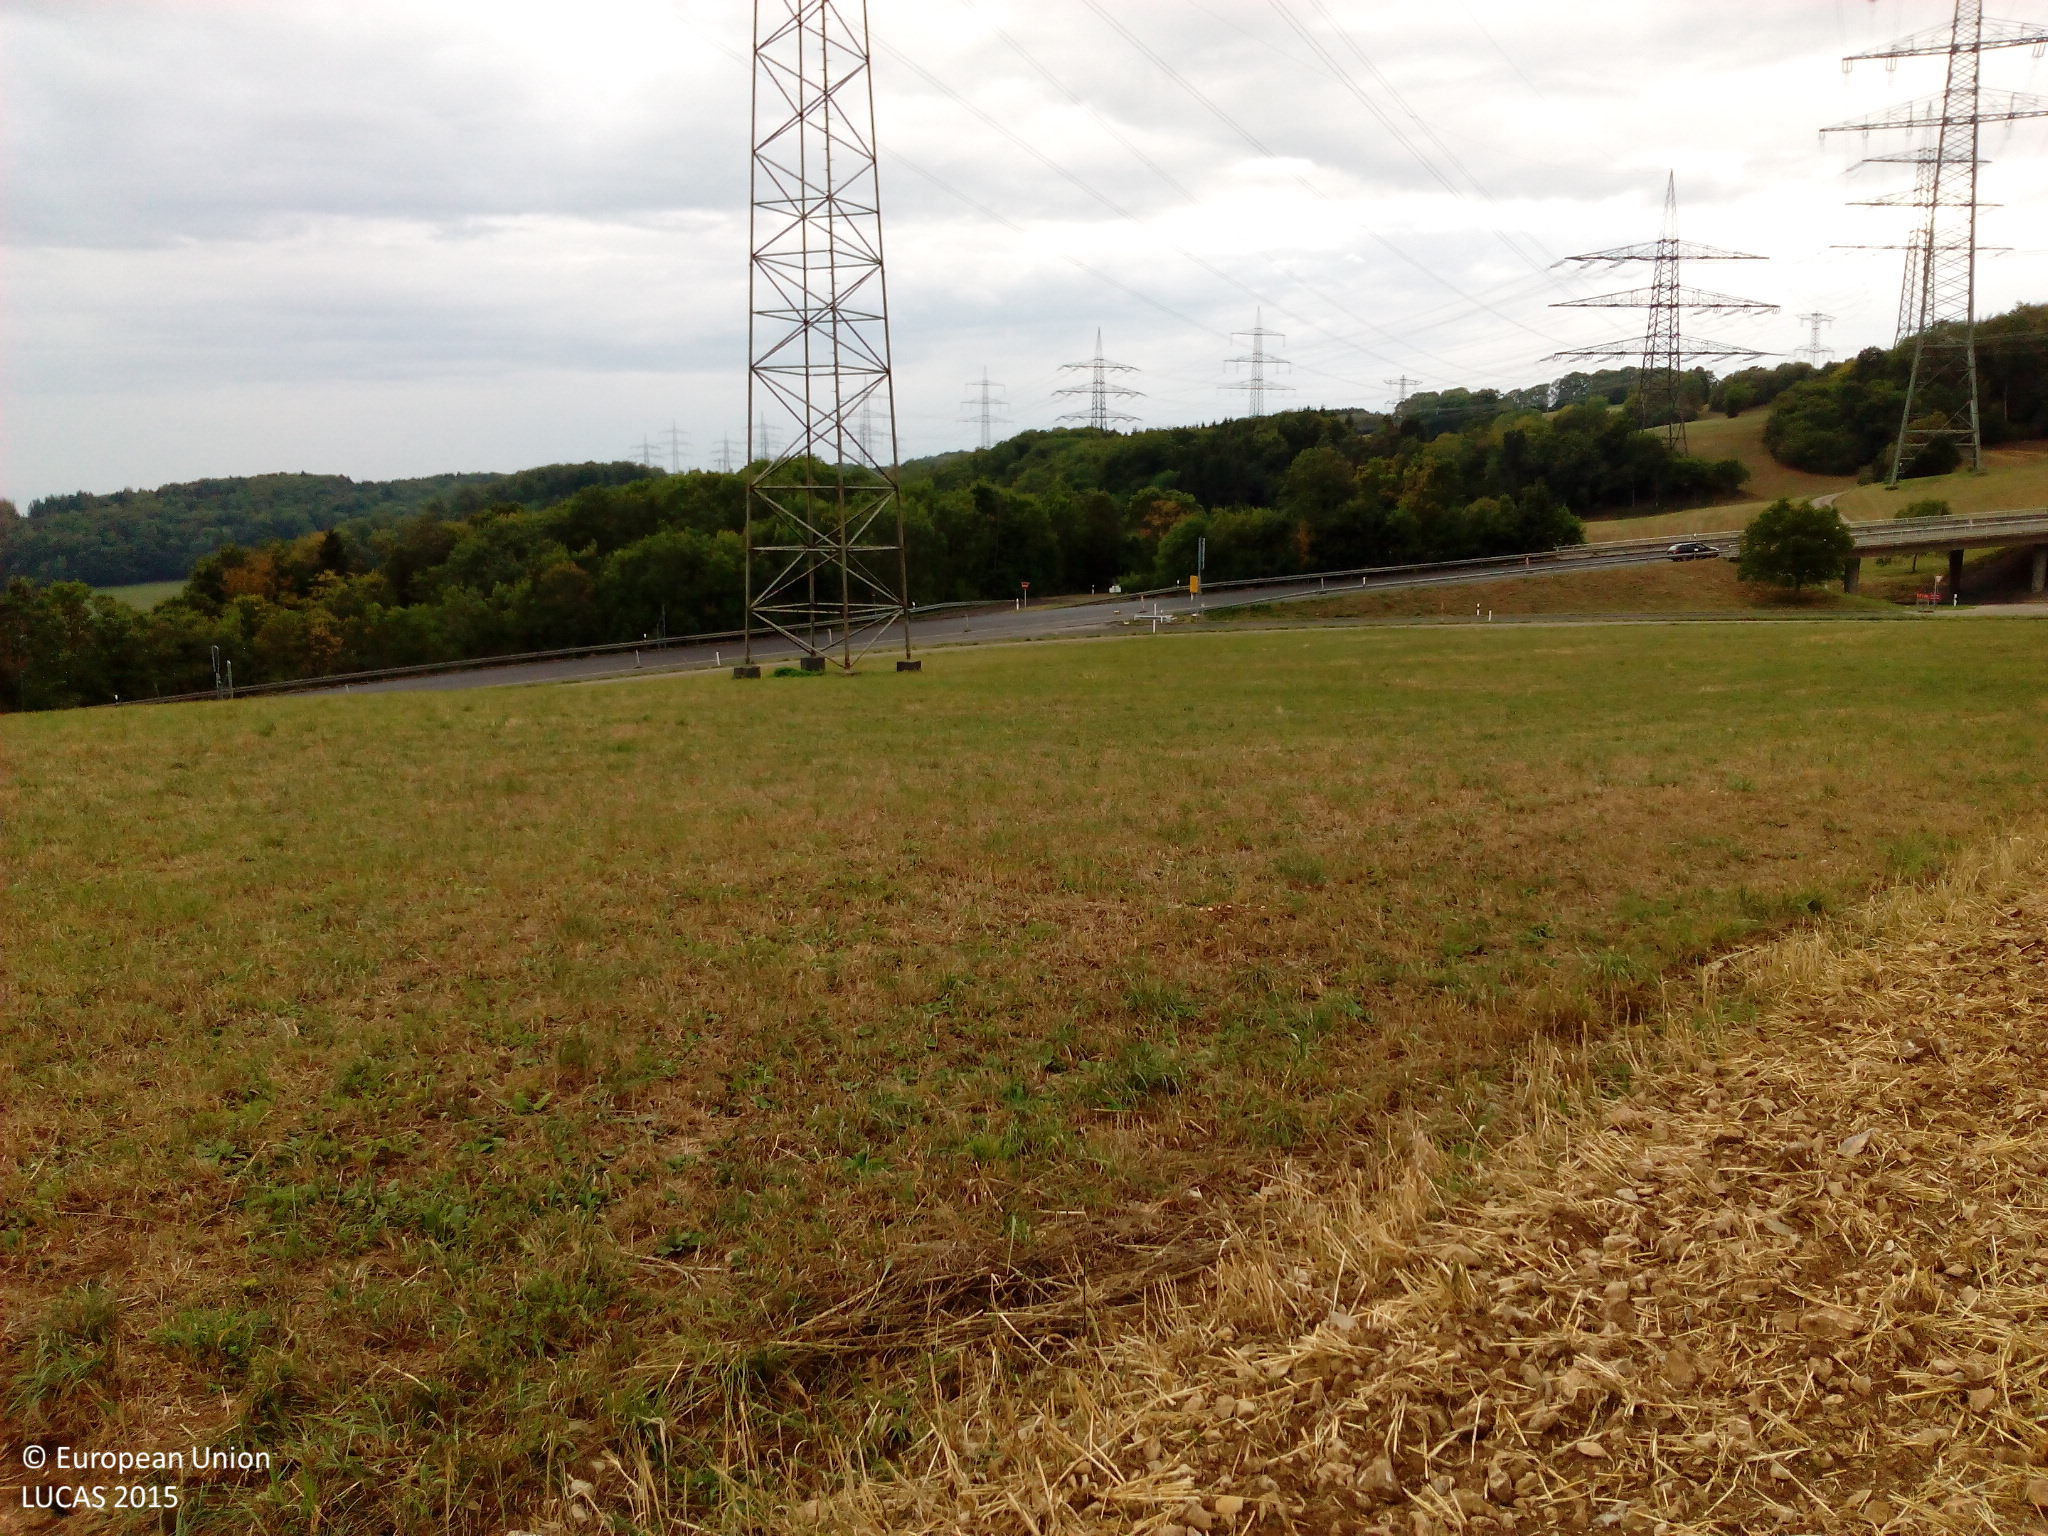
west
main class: Cropland
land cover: Common wheat
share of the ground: < 10 %
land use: Agriculture (excluding fallow land and kitchen gardens)
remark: Harvested field
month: August
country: DE
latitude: 47.6504
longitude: 8.1774
